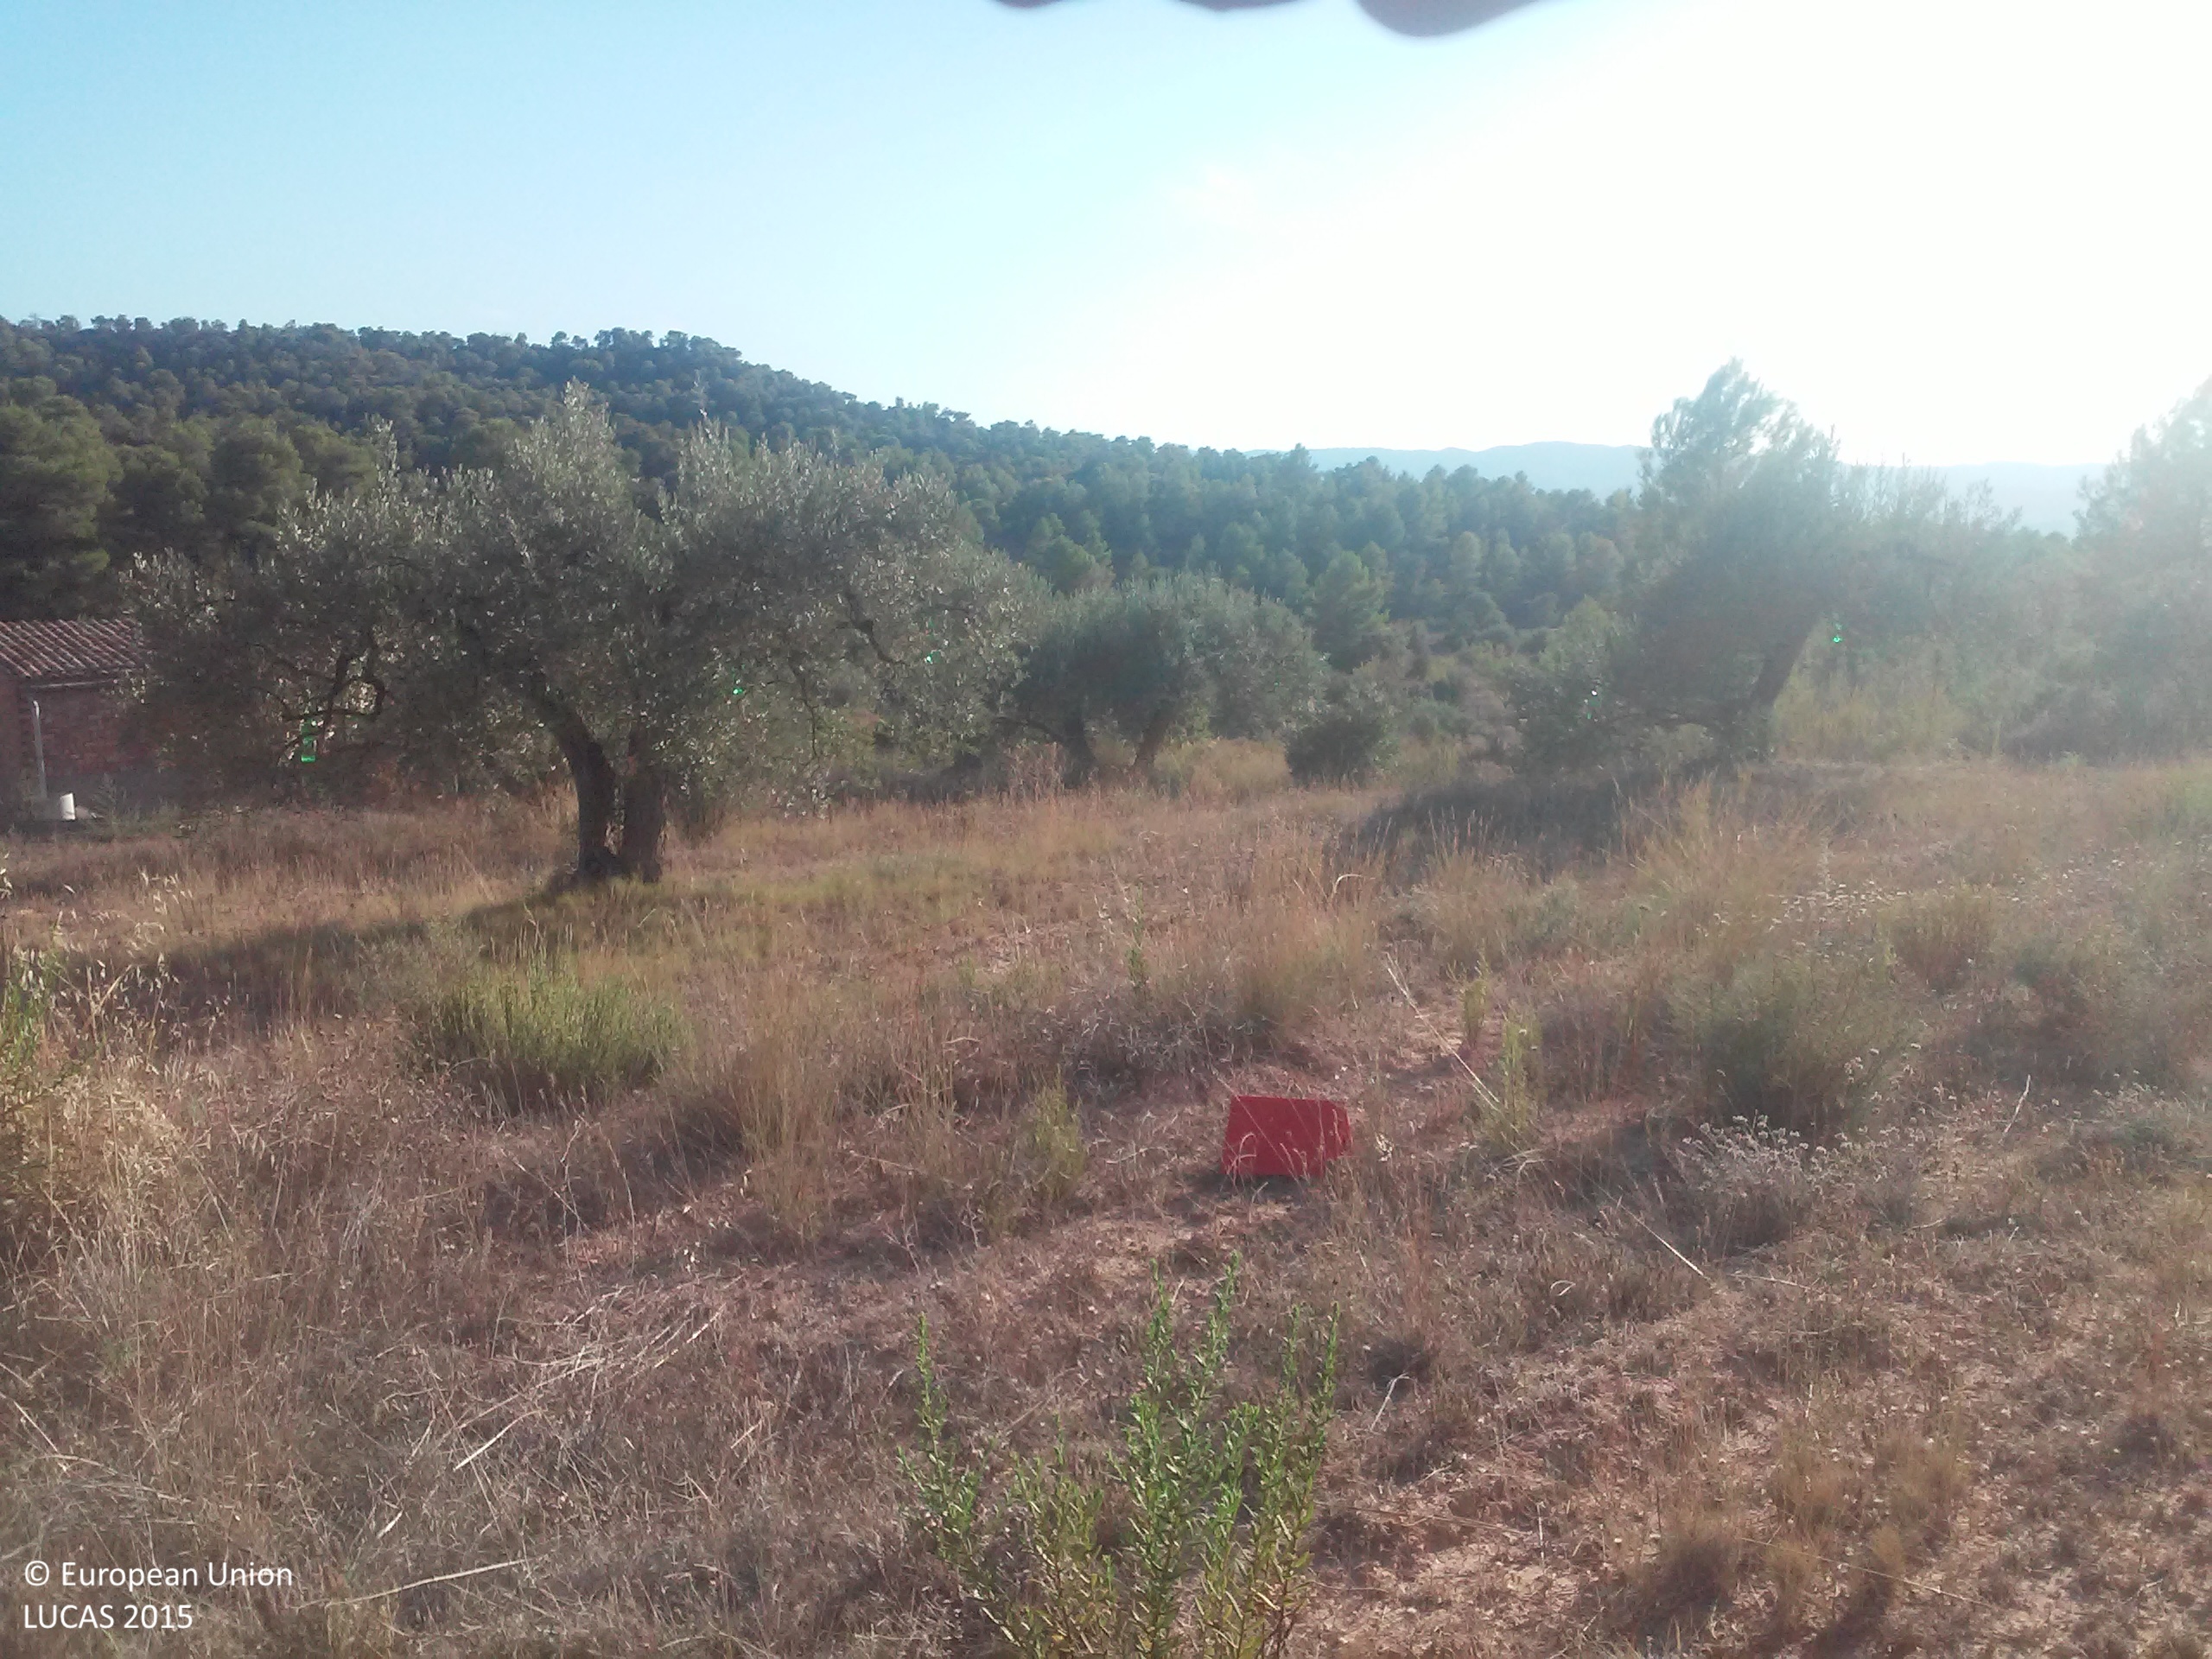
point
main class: Cropland
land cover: Olive groves
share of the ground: 10 - 25 %
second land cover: Grassland without tree/shrub cover
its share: > 75 %
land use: Agriculture (excluding fallow land and kitchen gardens)
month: August
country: ES
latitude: 41.2524
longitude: 0.5983
